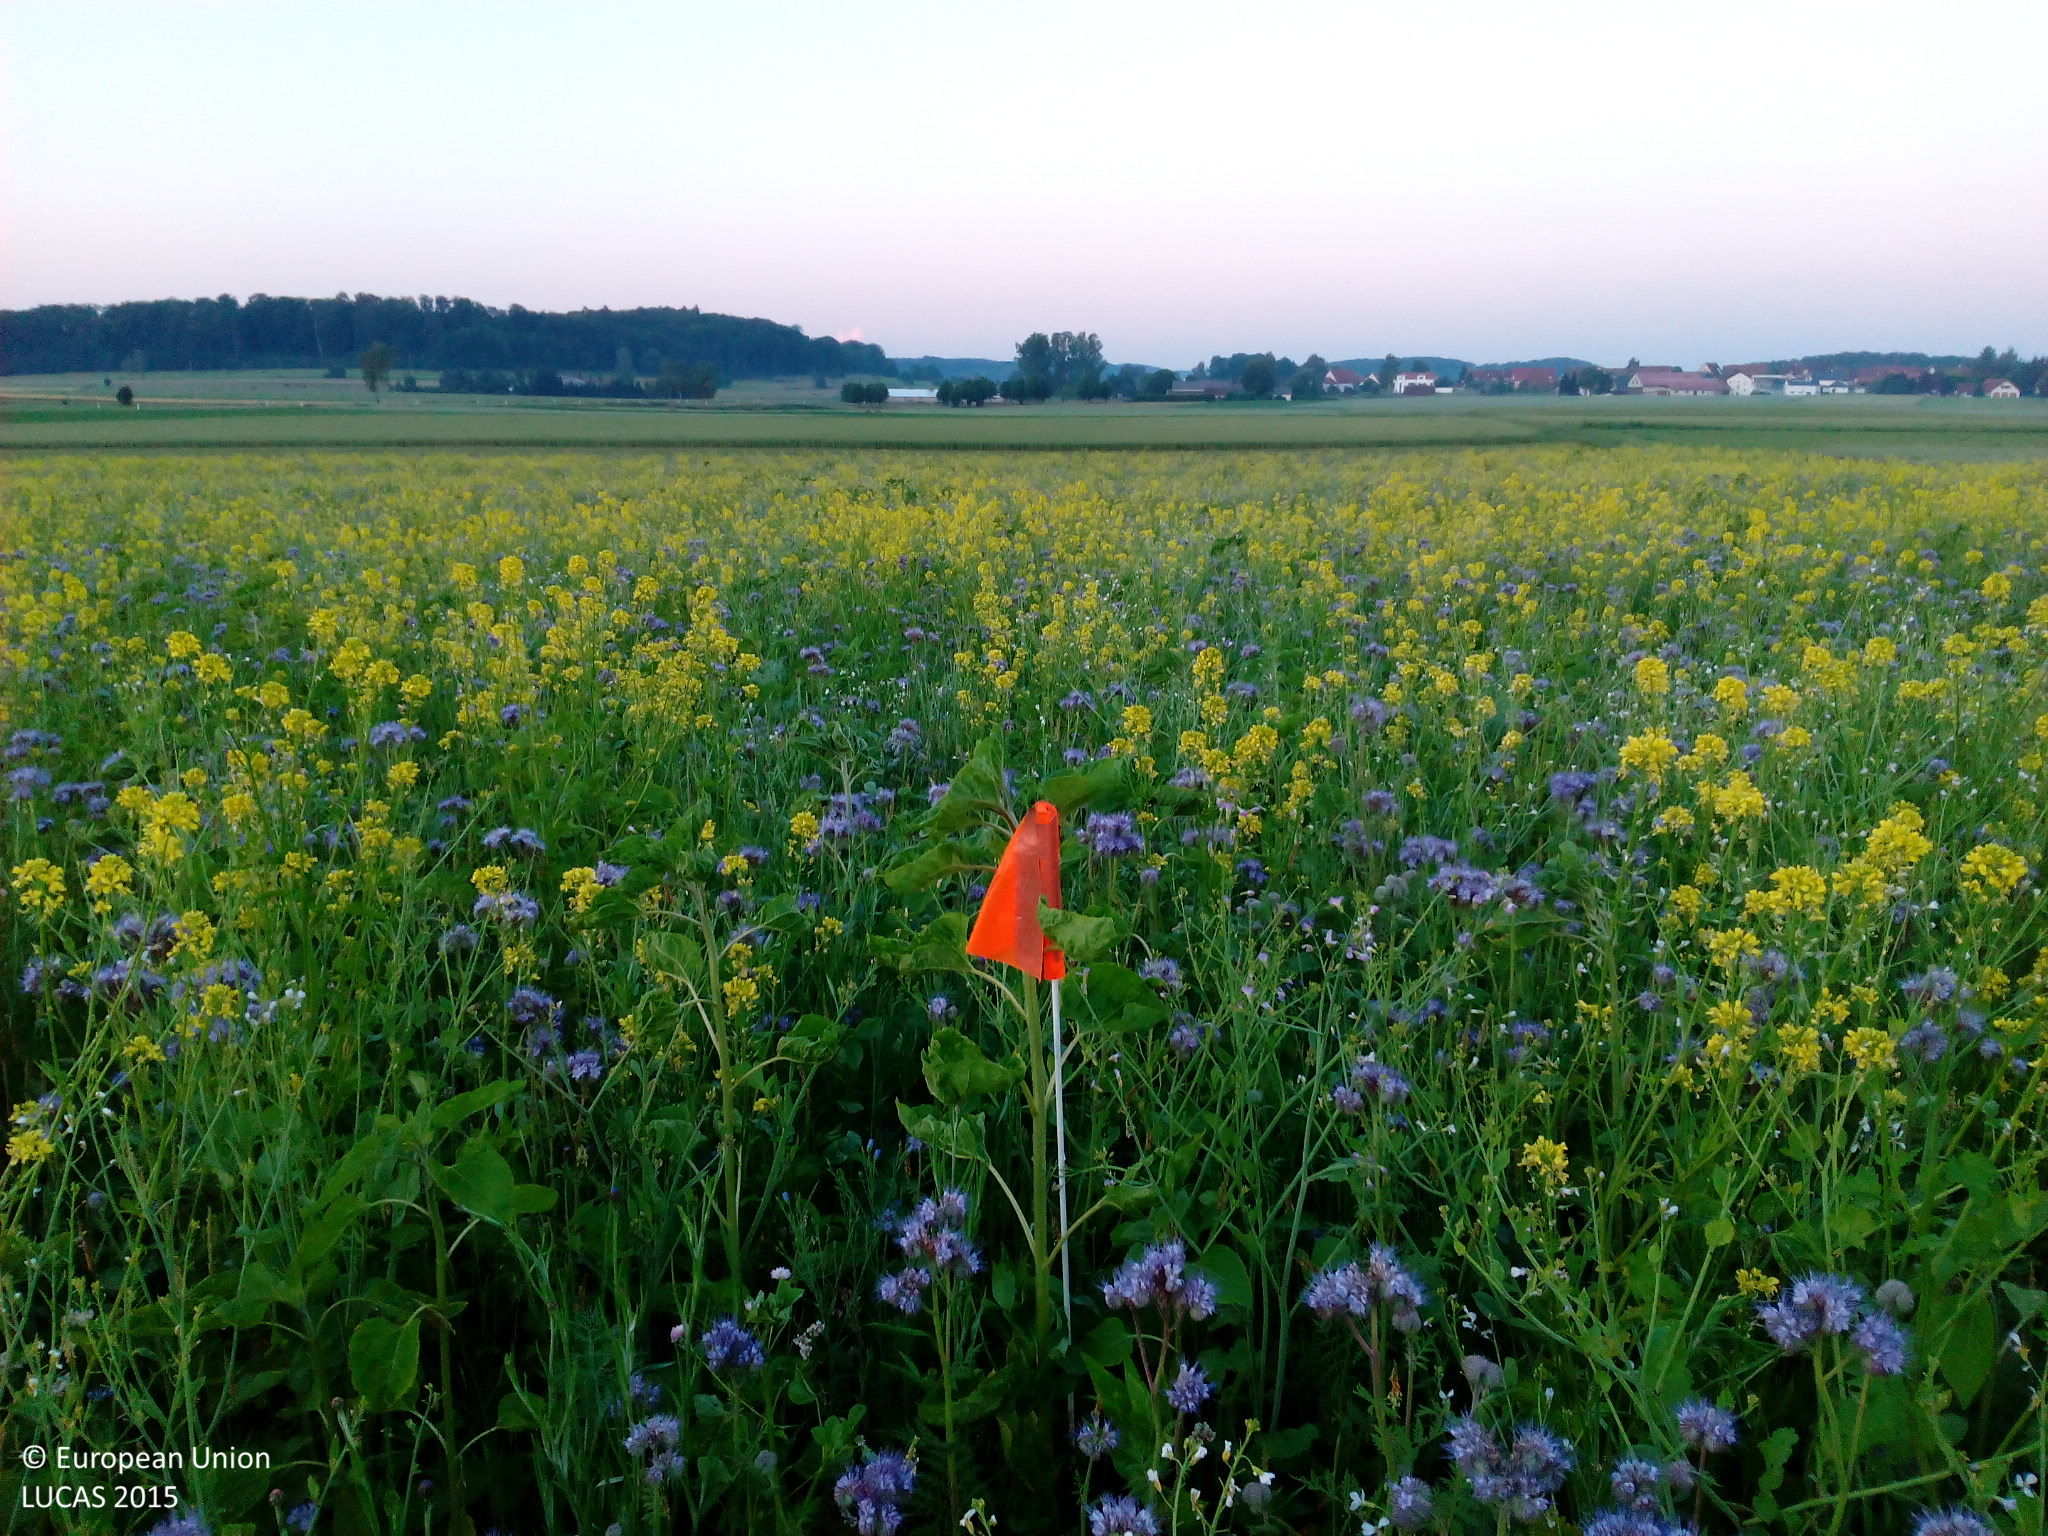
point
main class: Cropland
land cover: Other leguminous and mixtures for fodder
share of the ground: > 75 %
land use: Agriculture (excluding fallow land and kitchen gardens)
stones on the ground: < 10 %
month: July
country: DE
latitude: 48.3655
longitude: 9.3390
